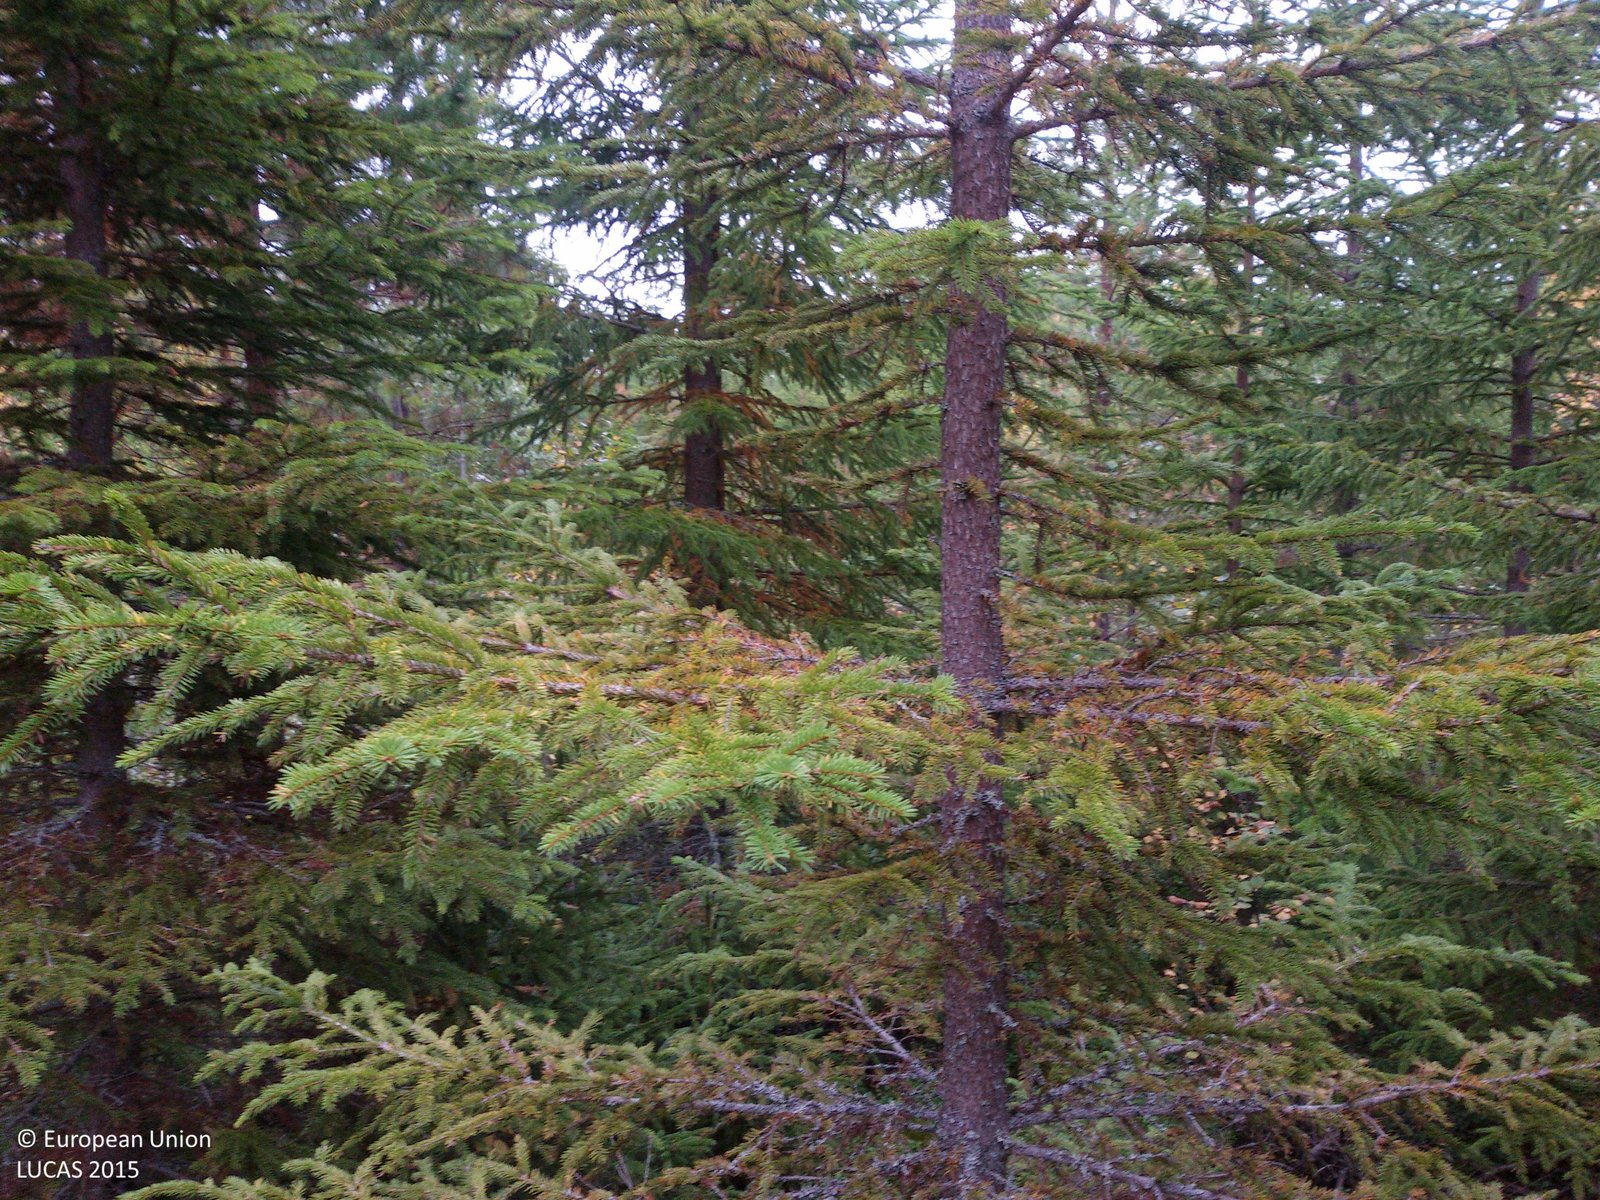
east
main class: Woodland
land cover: Spruce dominated coniferous woodland
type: boreal forest
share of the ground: 50 - 75 %
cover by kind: coniferous forest trees 70 %, lichens and mosses 15 %, shrubs 10 %, herbaceous plants 5 %
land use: Forestry
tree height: > 5 m
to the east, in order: Spruce dominated coniferous woodland; Pine dominated mixed woodland; Pine dominated coniferous woodland; Pine dominated mixed woodland; Tracks; Pine dominated mixed woodland; Spruce dominated mixed woodland
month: September
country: SE
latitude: 60.6880
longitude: 14.9863
